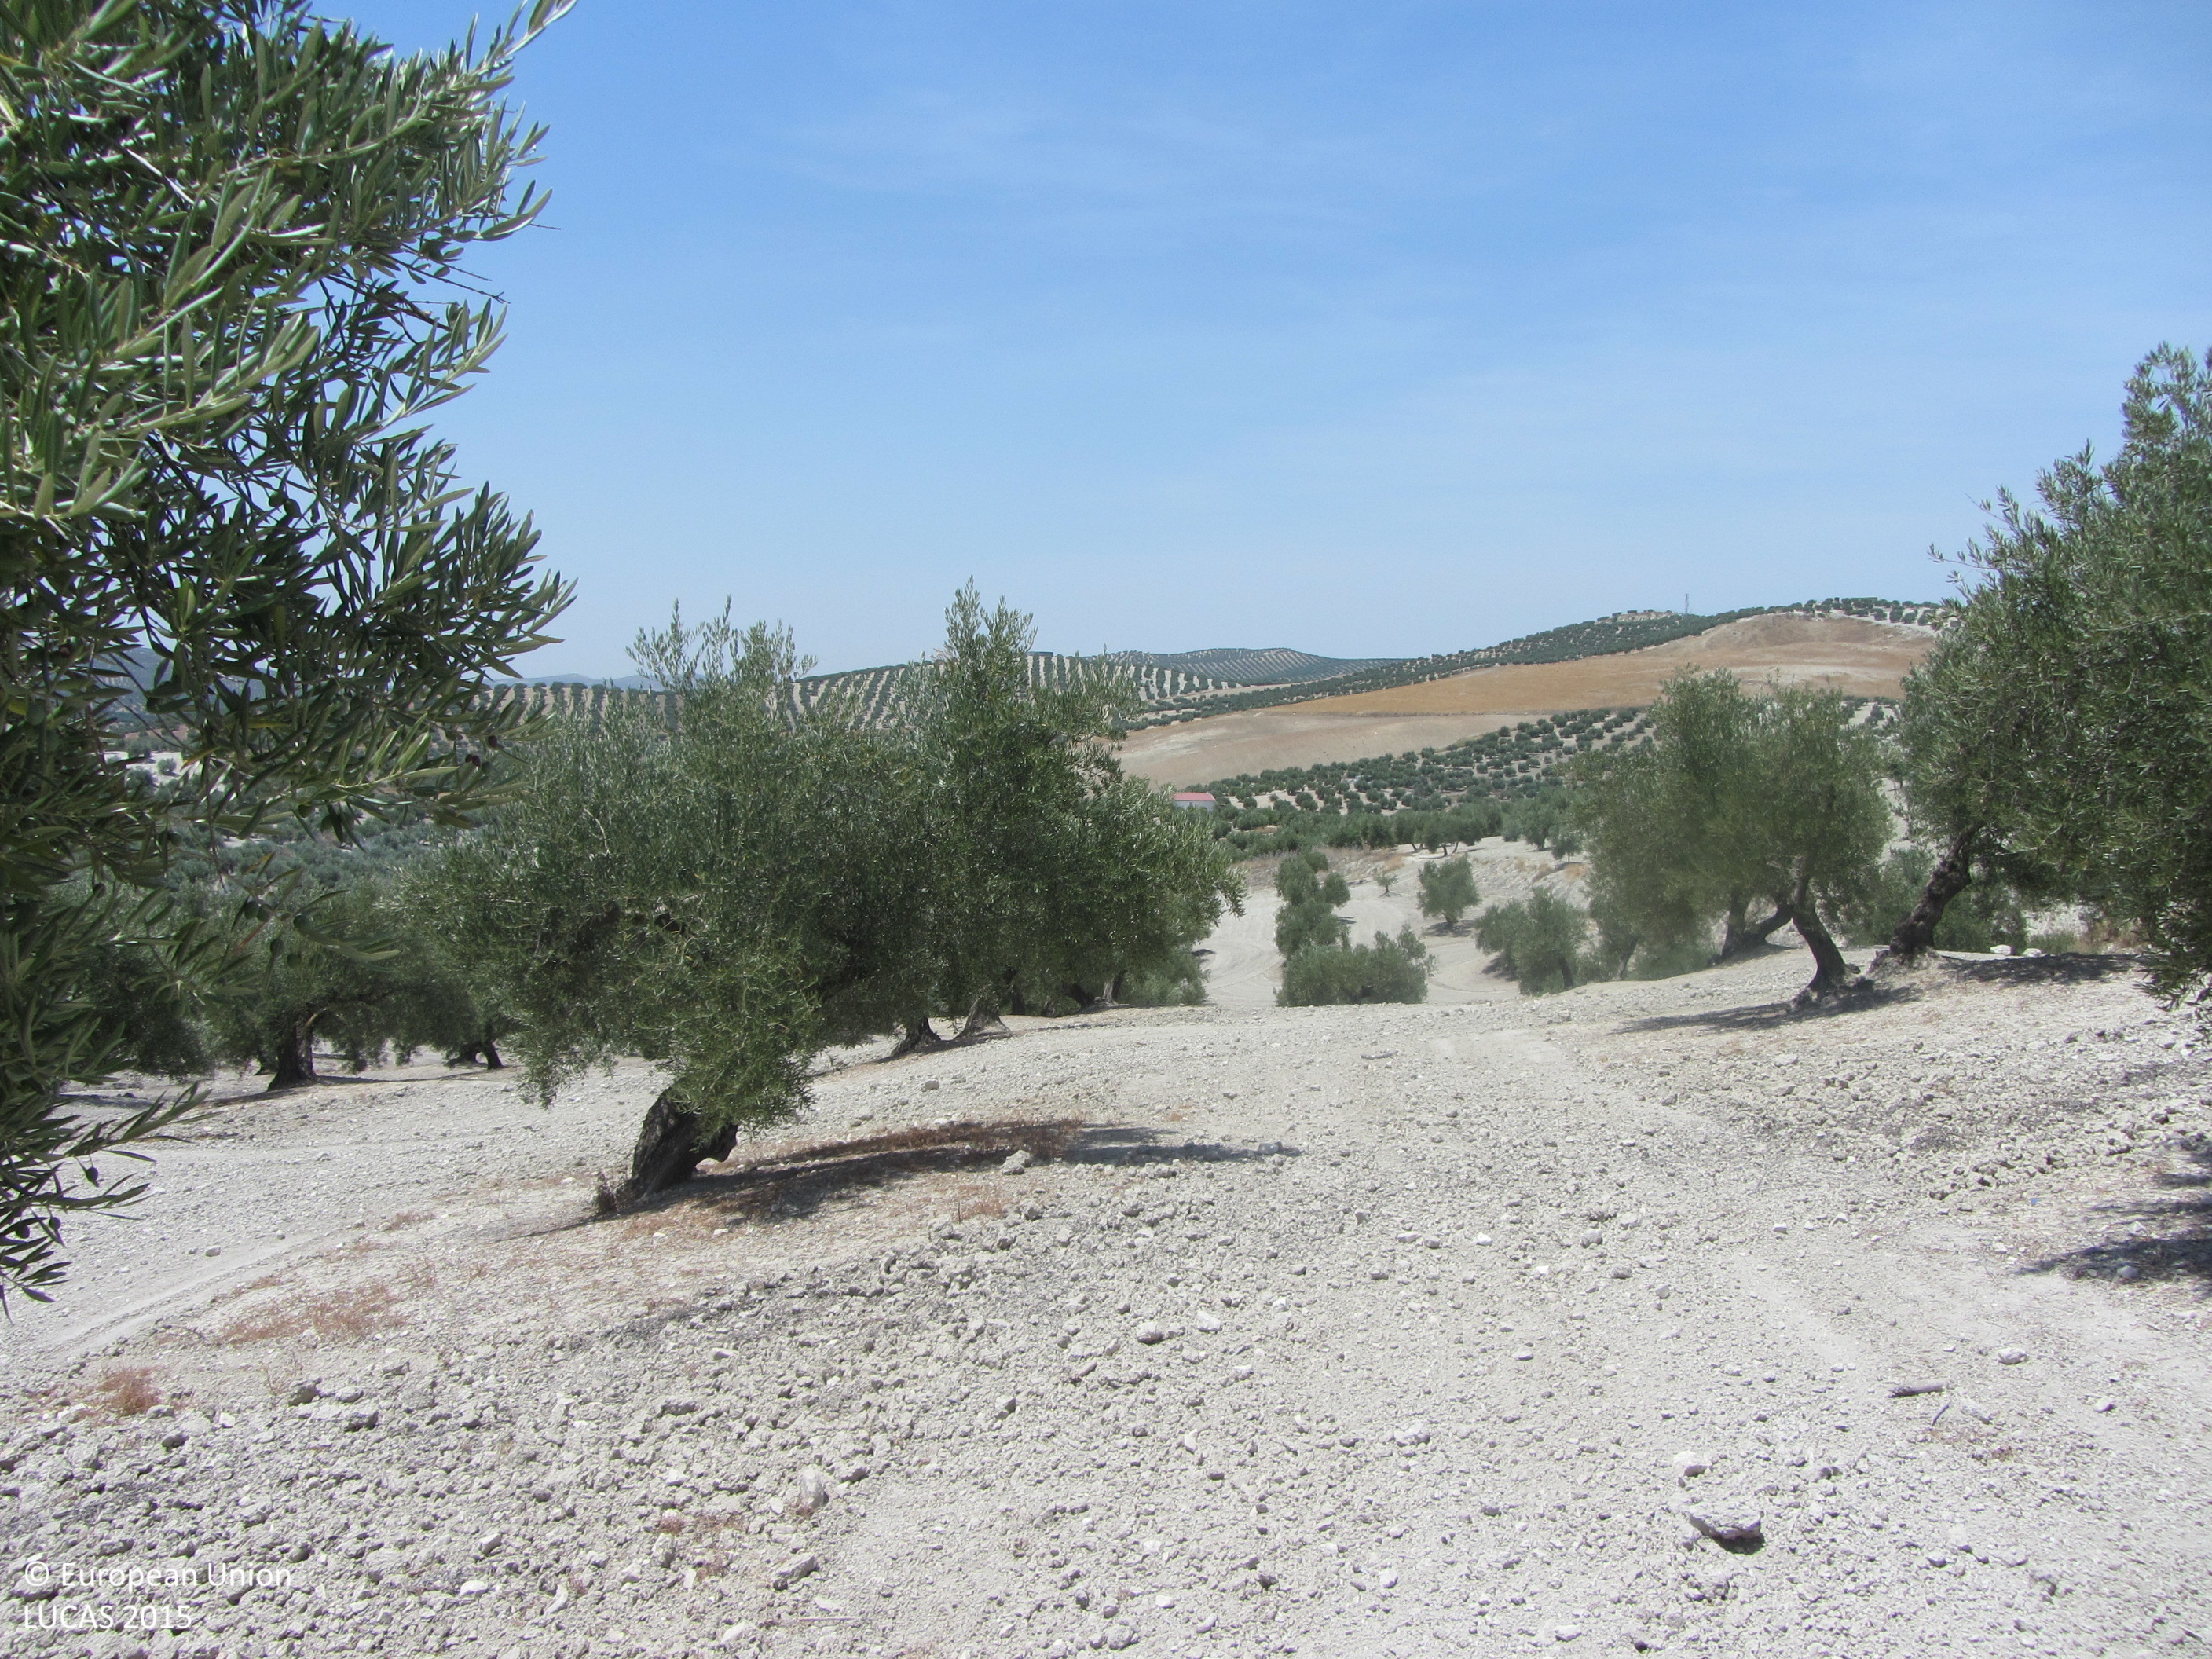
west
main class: Cropland
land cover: Olive groves
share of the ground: 25 - 50 %
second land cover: Other bare soil
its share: > 75 %
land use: Agriculture (excluding fallow land and kitchen gardens)
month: July
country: ES
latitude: 37.7484
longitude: -4.1569
